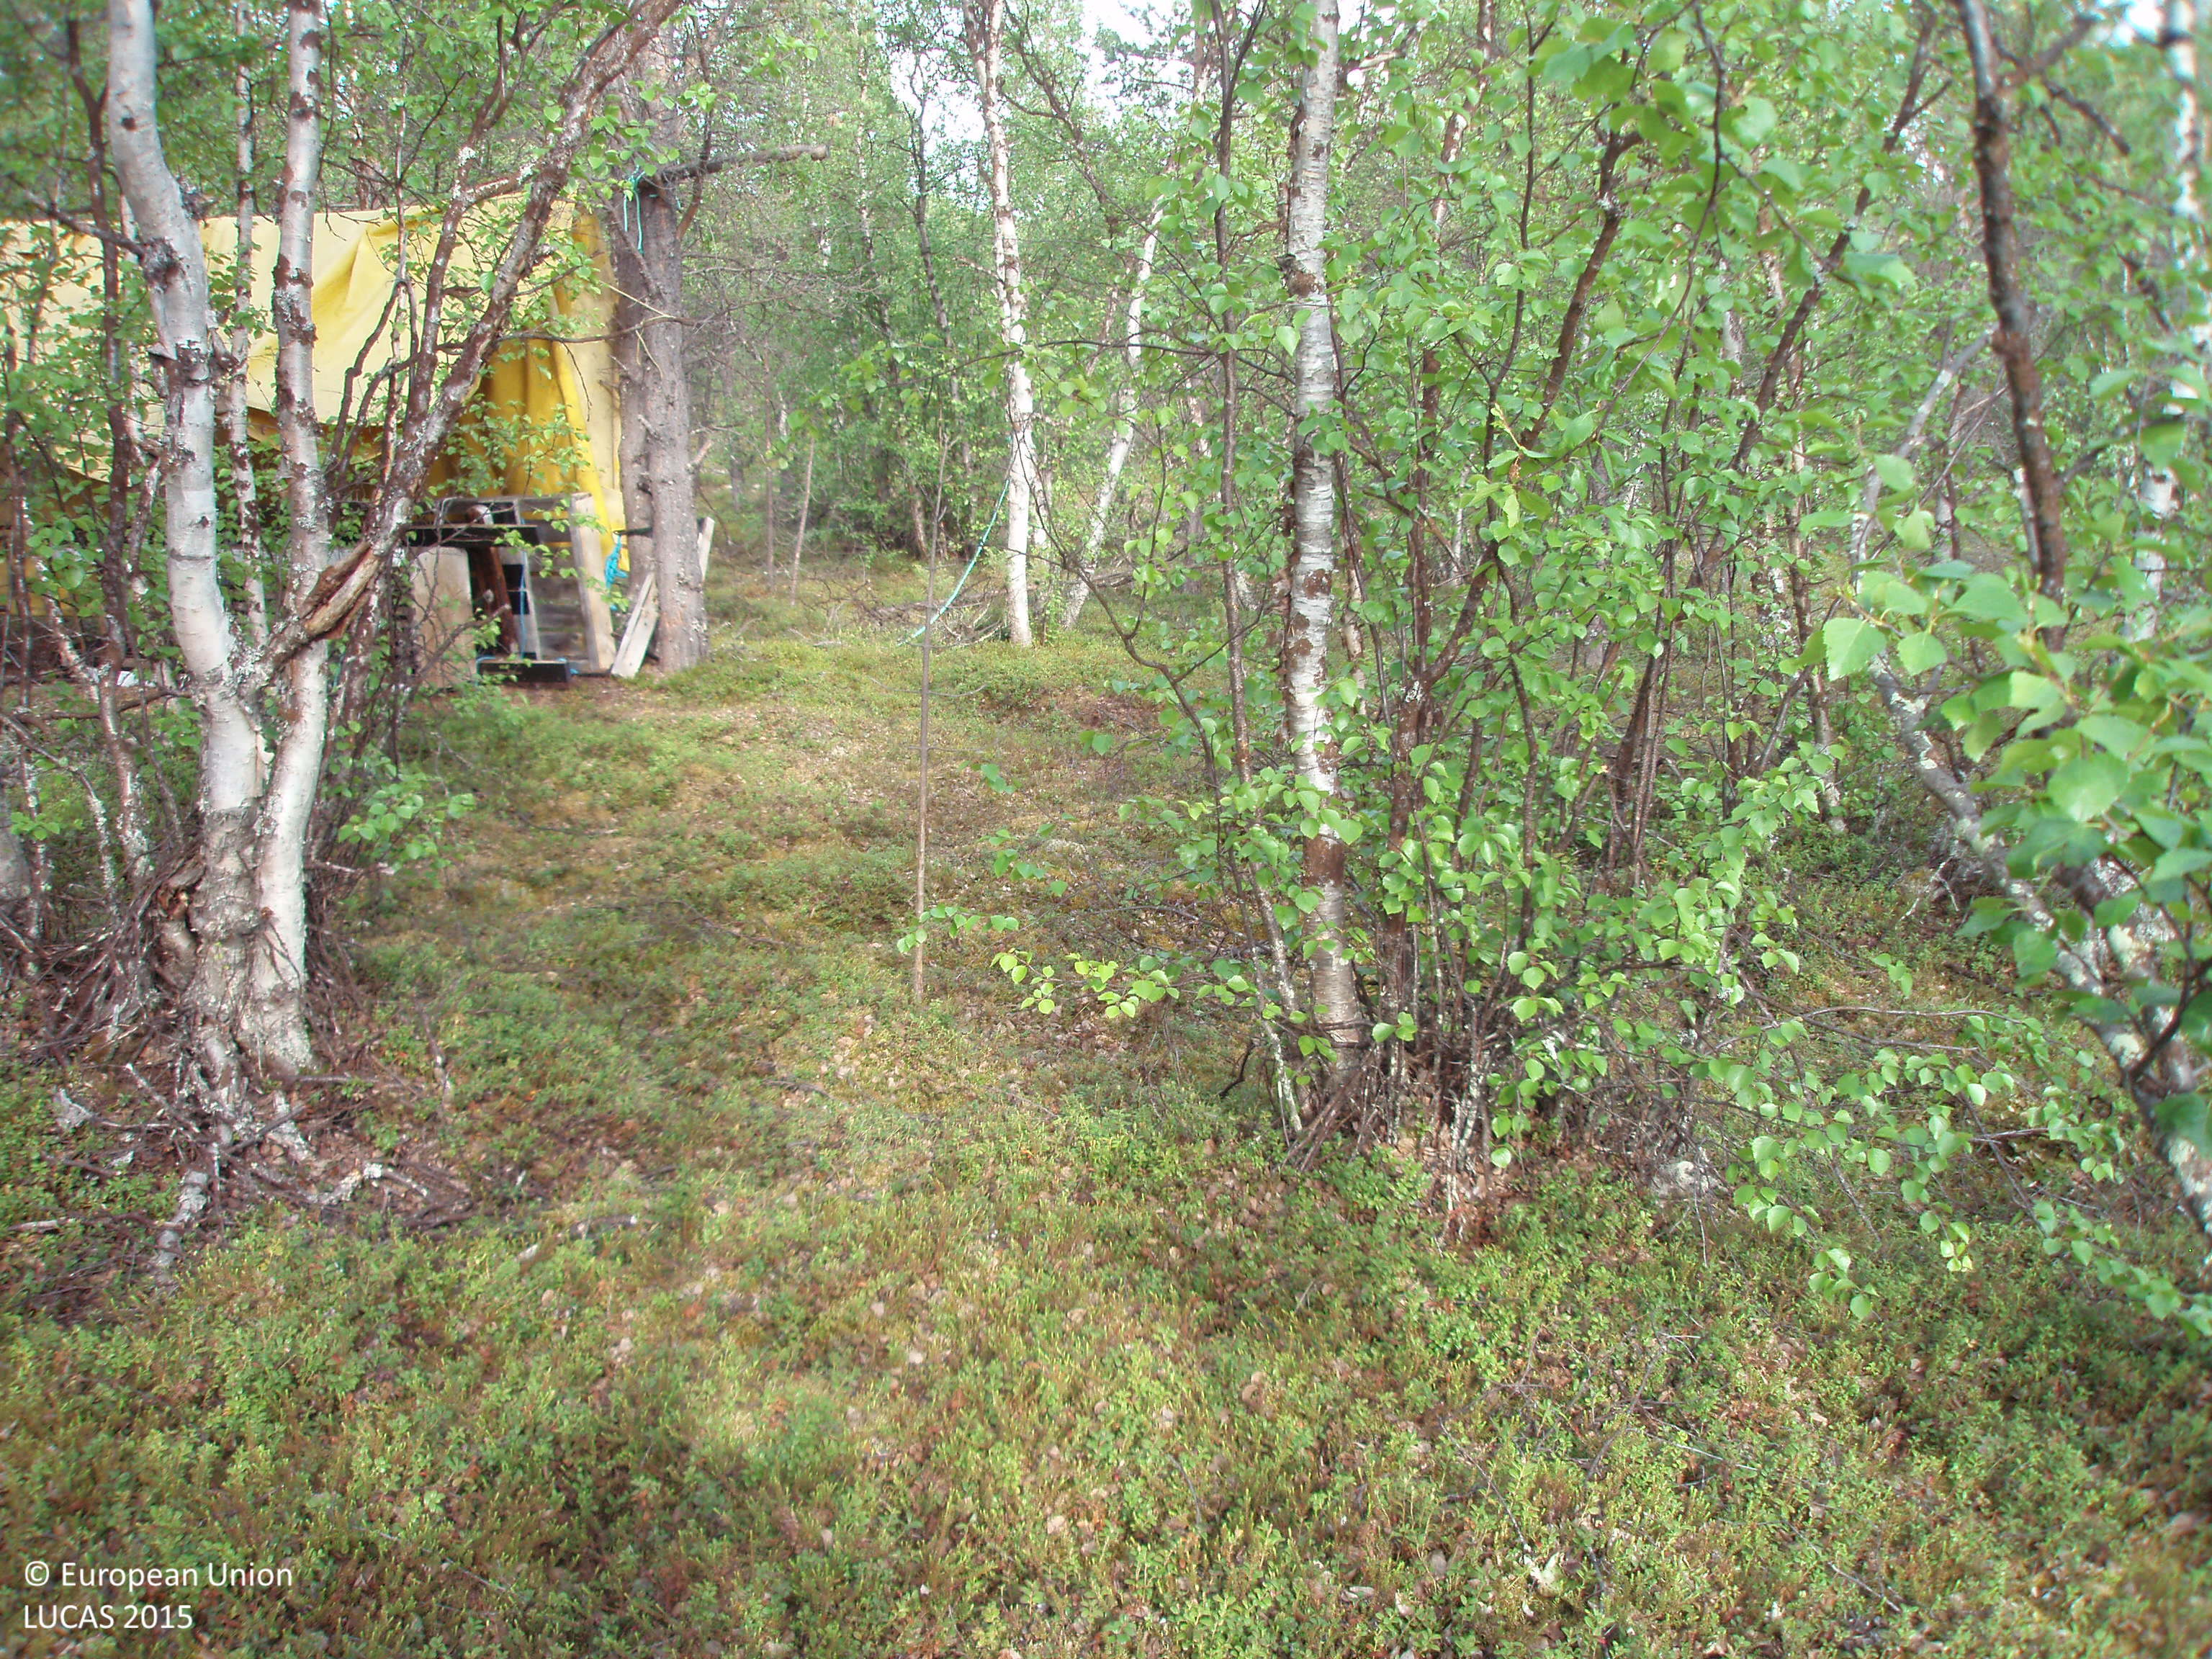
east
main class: Woodland
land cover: Pine dominated mixed woodland
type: boreal forest
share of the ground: > 75 %
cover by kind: broadleaved forest trees 60 %, coniferous forest trees 30 %, shrubs 10 %
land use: Forestry
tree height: > 5 m
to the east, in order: Pine dominated mixed woodland; Artificial constructions in urban areas; Pine dominated mixed woodland; Broadleaved woodland; Inland fresh running water; Broadleaved woodland; Inland fresh running water; Shruby margins; Inland fresh running water; Shrubland with sparse tree cover
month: July
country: FI
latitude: 69.0612
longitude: 25.7497
